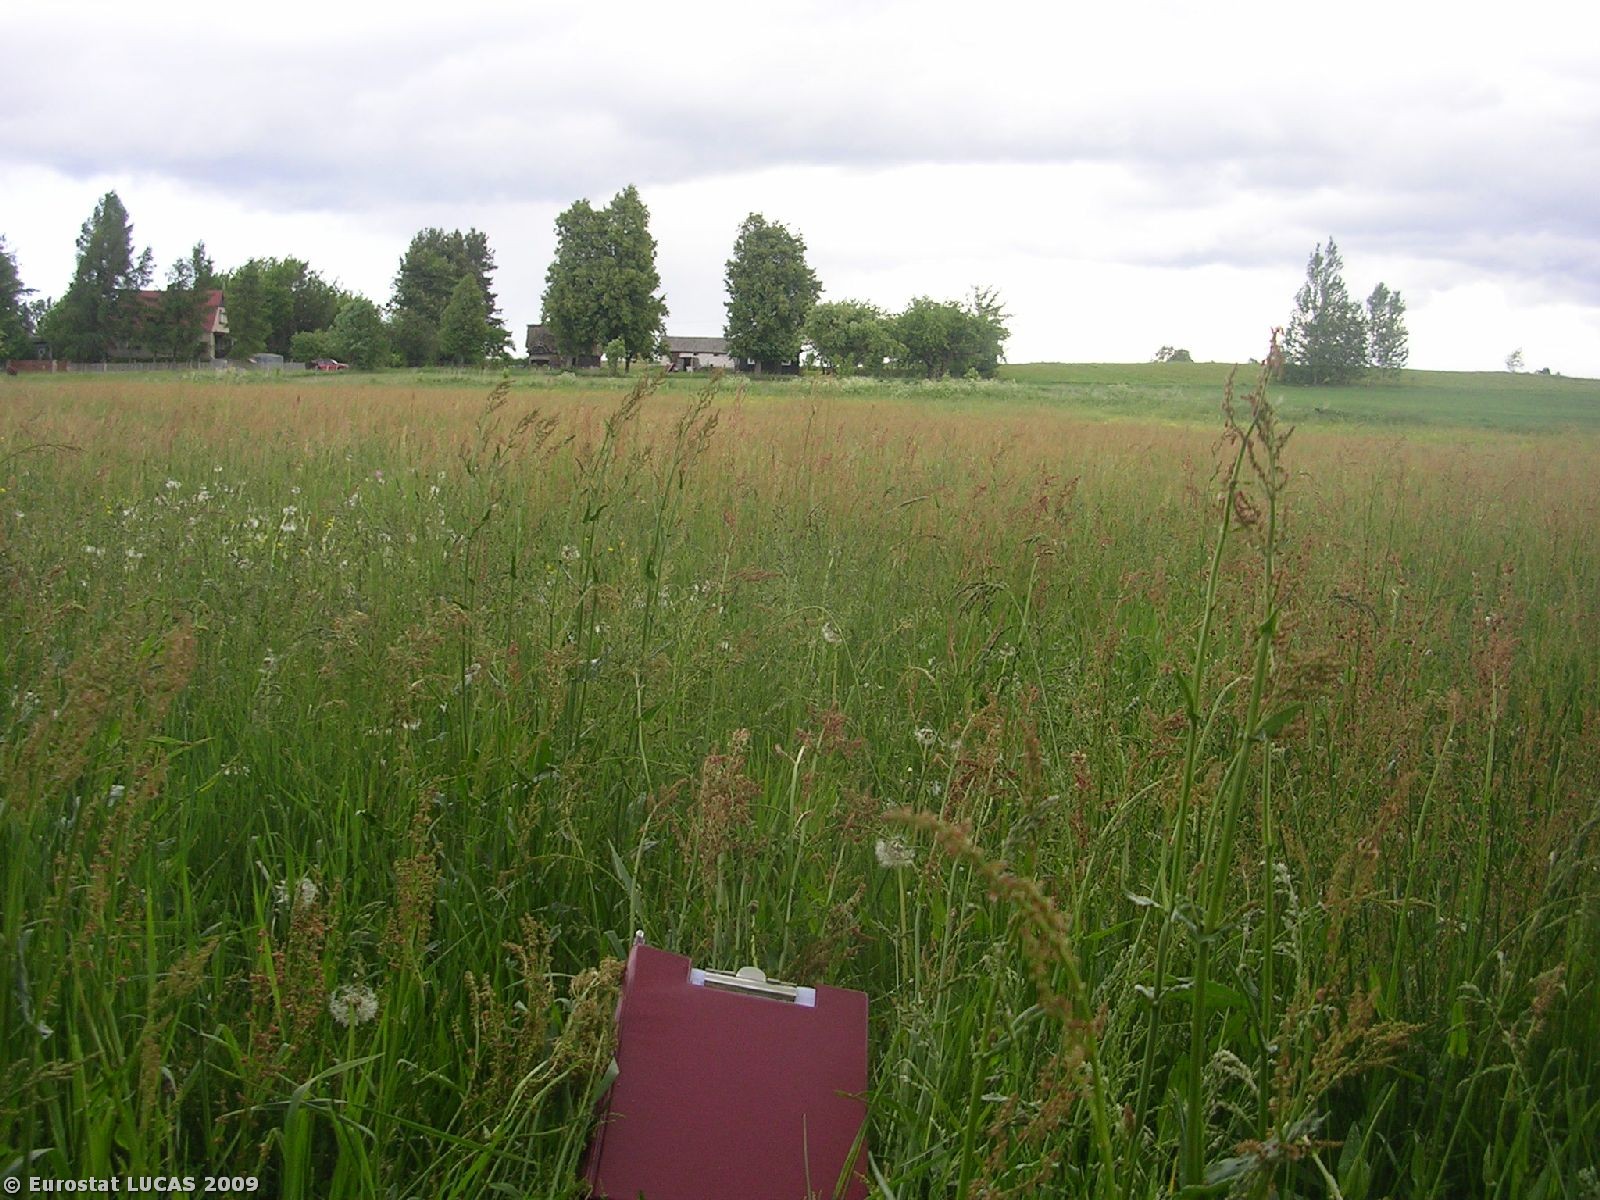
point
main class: Grassland
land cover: Grassland without tree/shrub cover
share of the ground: > 75 %
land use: Agriculture (excluding fallow land and kitchen gardens)
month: April
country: PL
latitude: 53.4728
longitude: 23.5689
